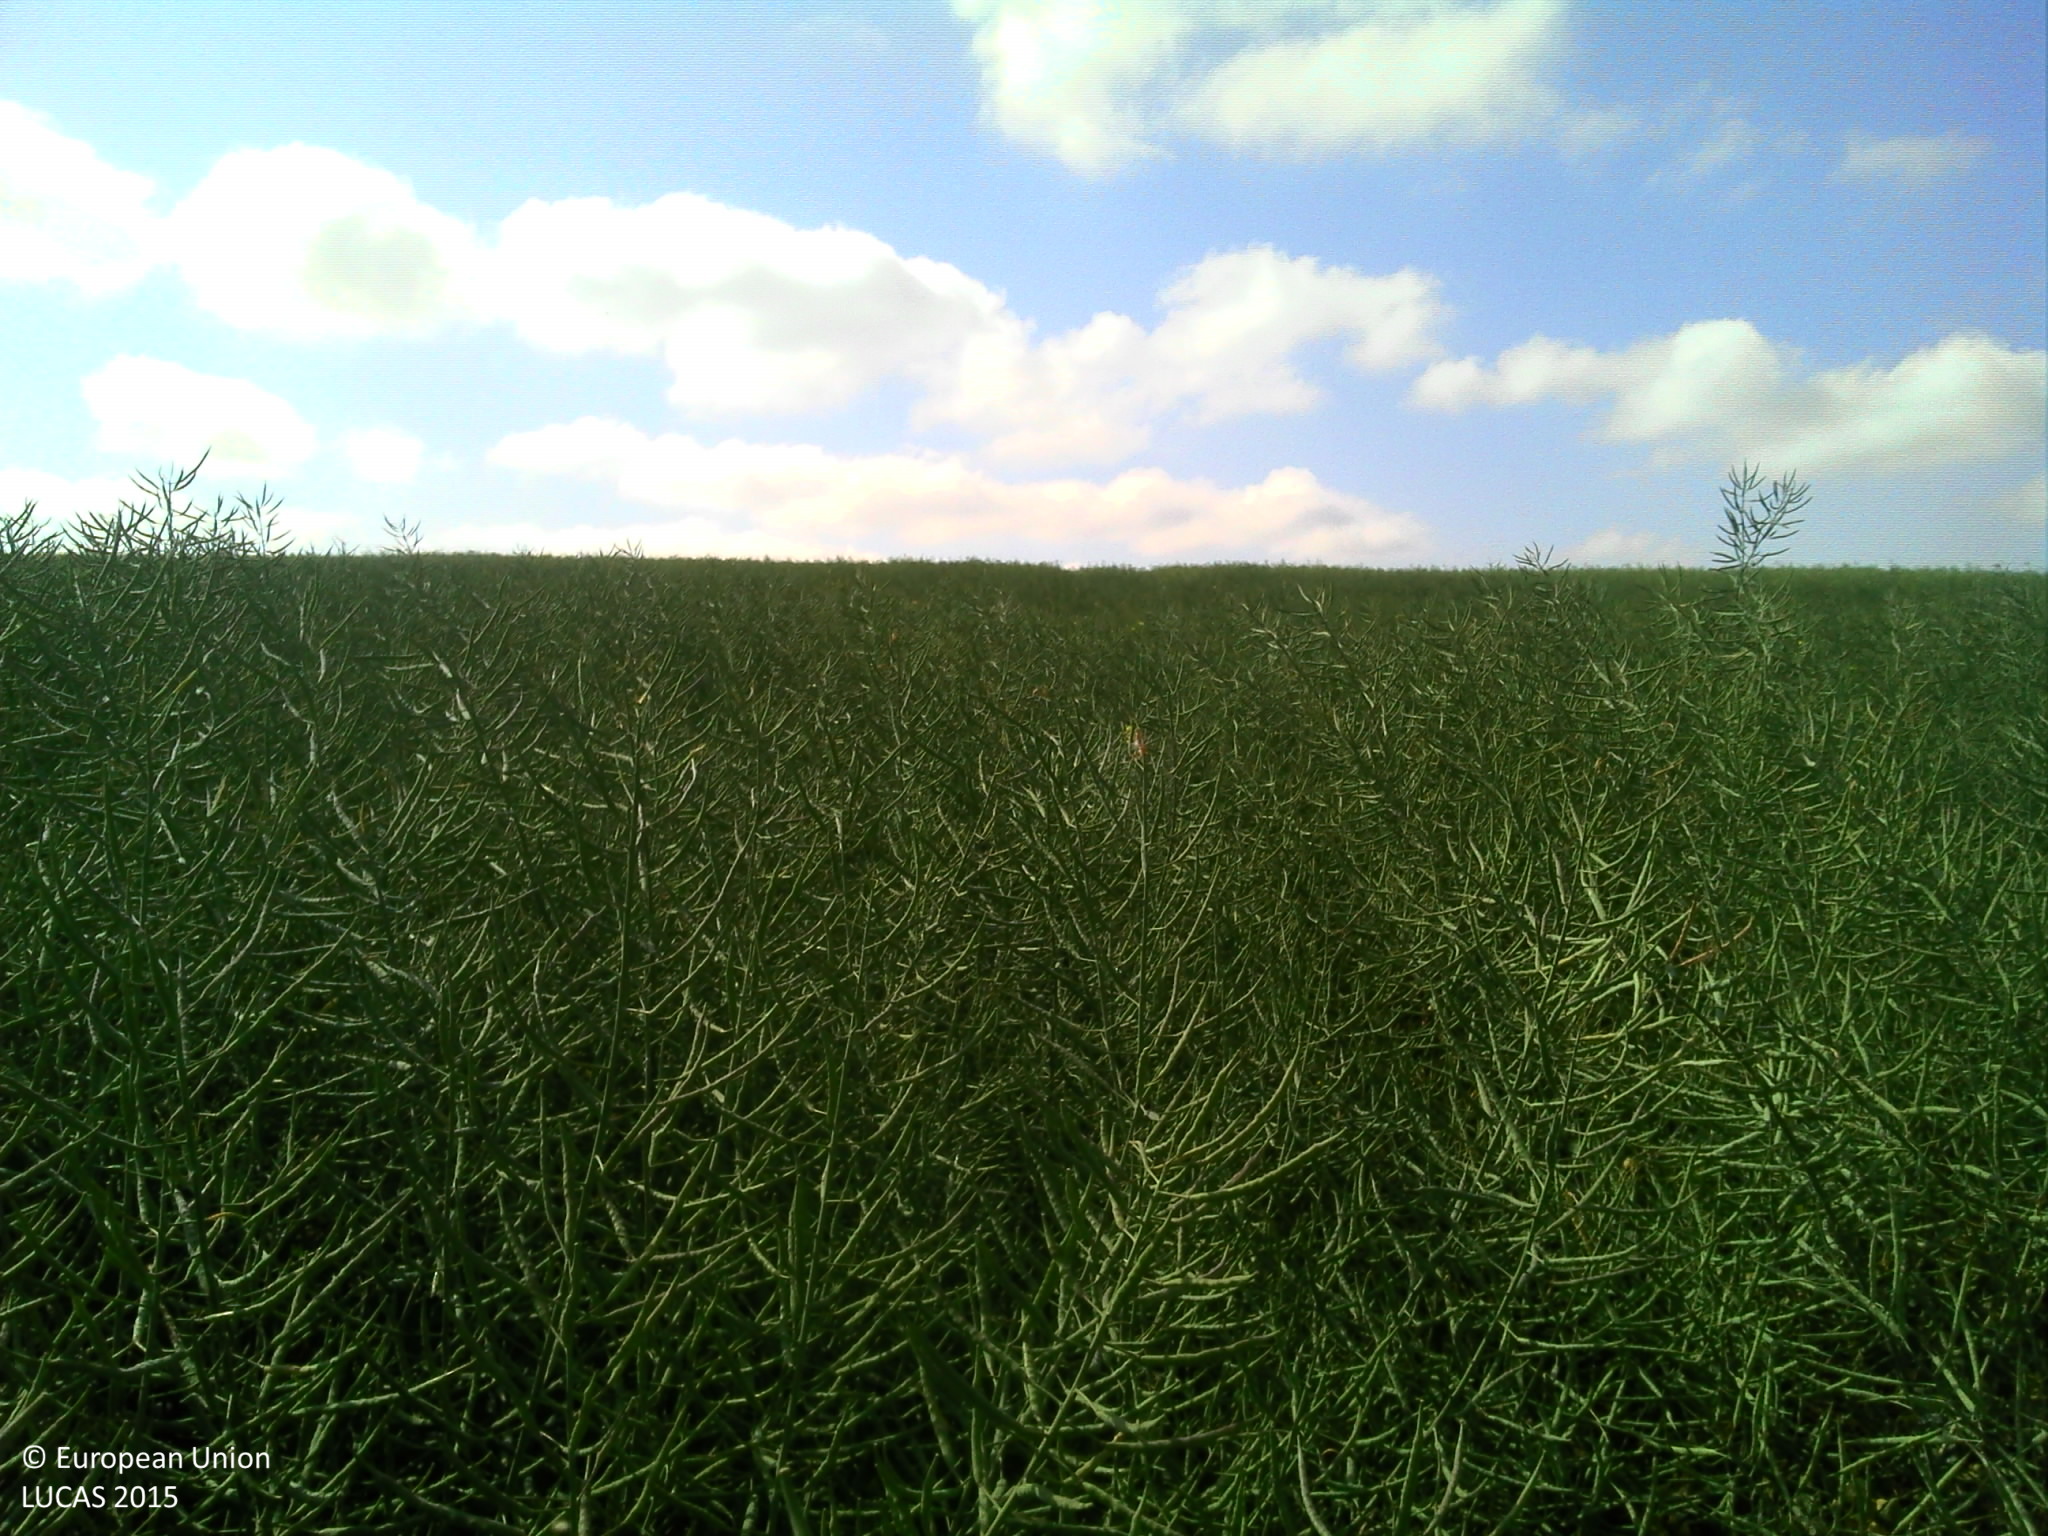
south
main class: Cropland
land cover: Rape and turnip rape
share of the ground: > 75 %
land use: Agriculture (excluding fallow land and kitchen gardens)
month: June
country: BE
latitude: 50.4017
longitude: 4.6641
